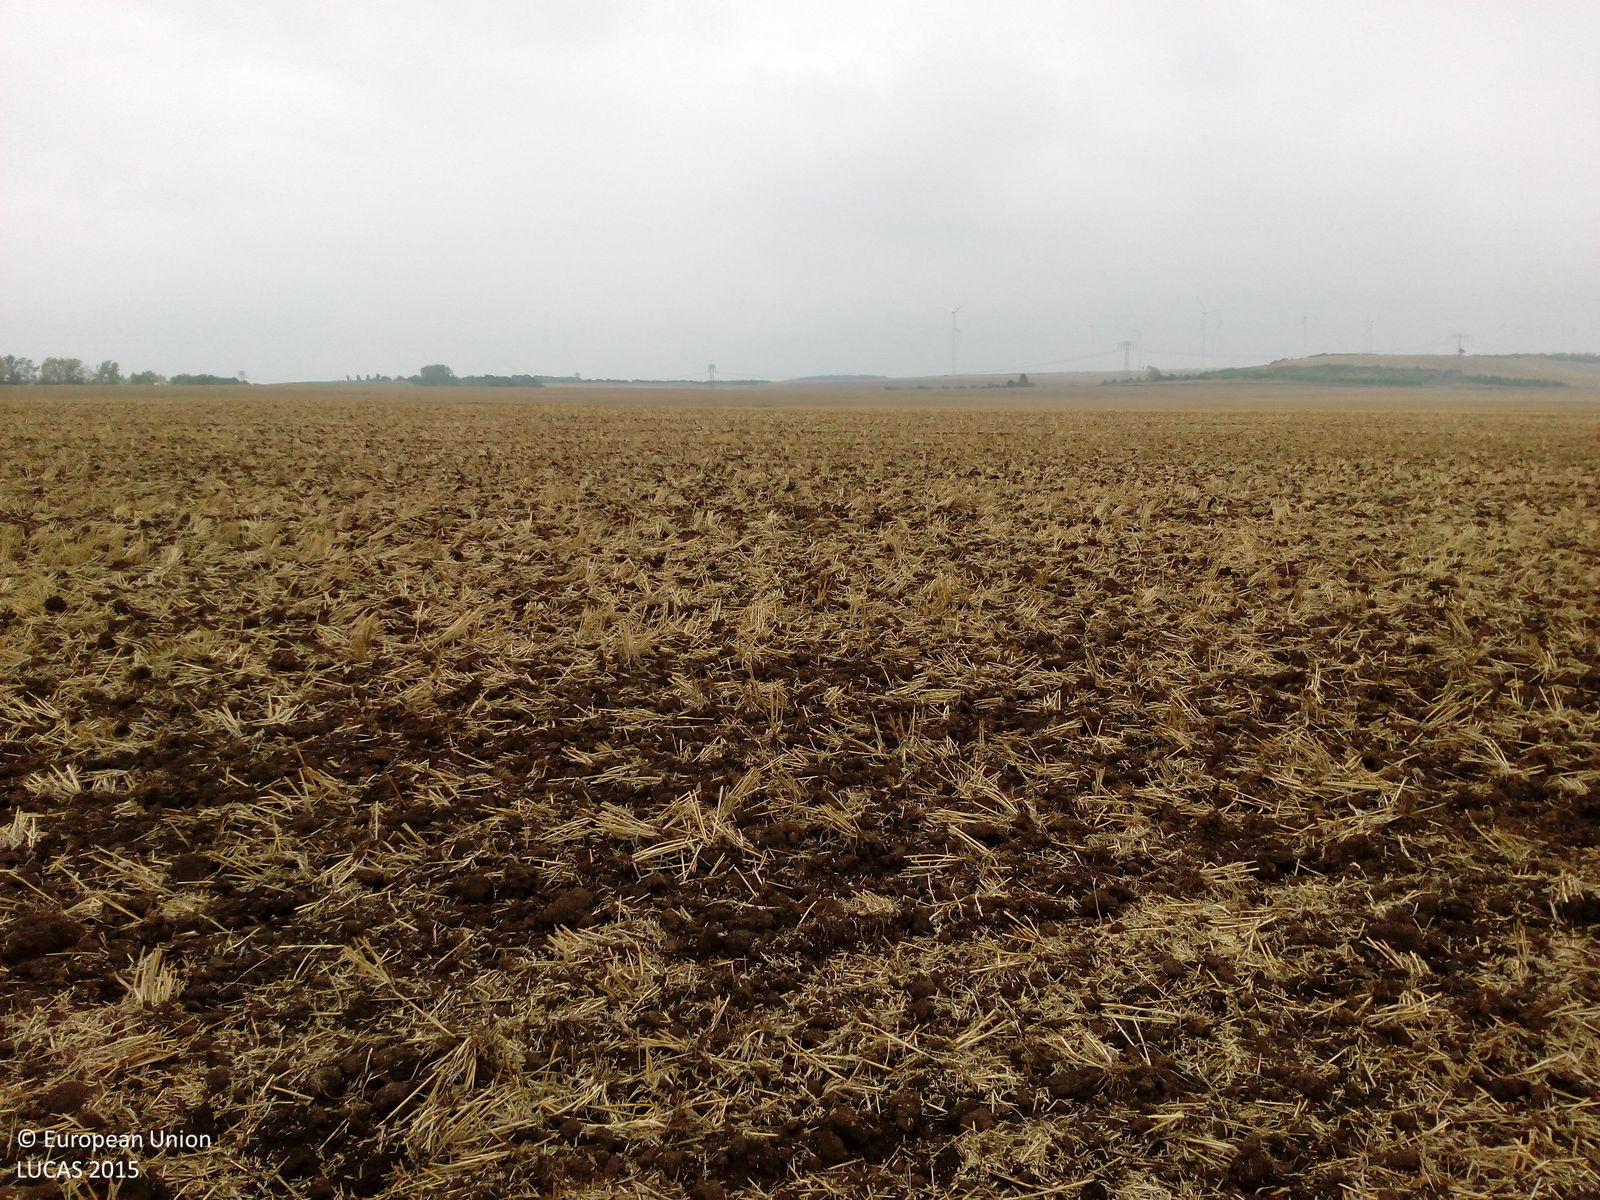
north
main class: Cropland
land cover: Common wheat
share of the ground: < 10 %
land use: Agriculture (excluding fallow land and kitchen gardens)
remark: Harvested field
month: August
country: DE
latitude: 51.0064
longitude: 11.0686
